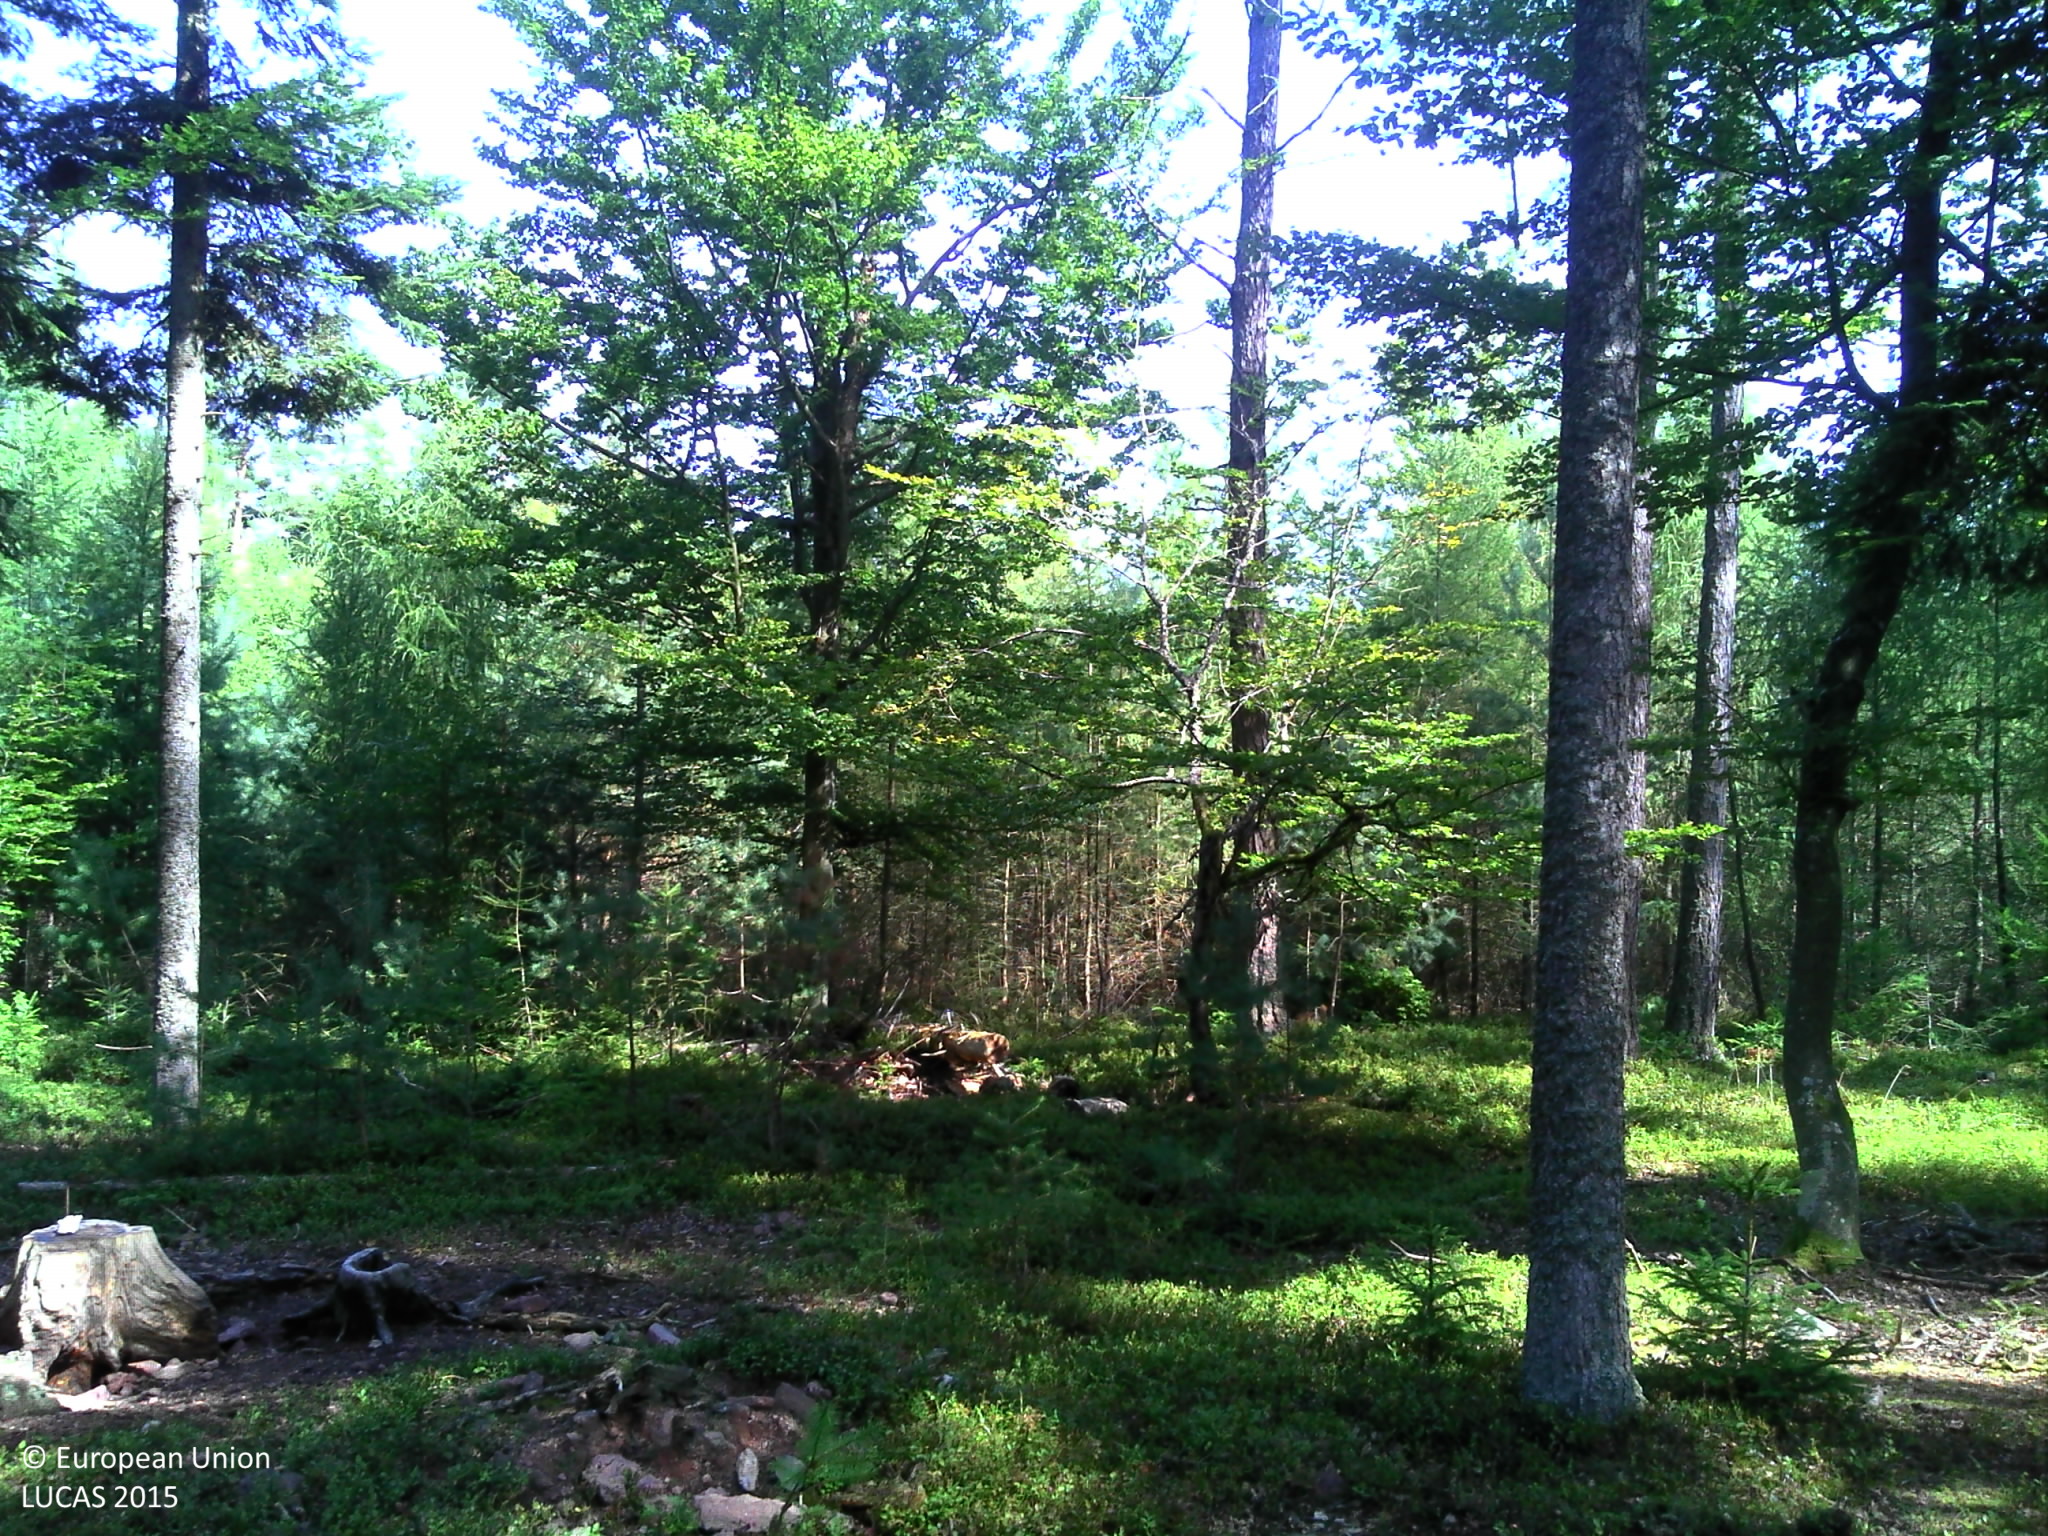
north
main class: Woodland
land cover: Spruce dominated mixed woodland
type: hemiboreal forest and nemoral coniferous forest and mixed broadleaved-coniferous forest
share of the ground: > 75 %
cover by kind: coniferous forest trees 60 %, broadleaved forest trees 30 %, herbaceous plants 10 %
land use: Forestry
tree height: > 5 m
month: August
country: FR
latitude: 48.2637
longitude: 7.3472
